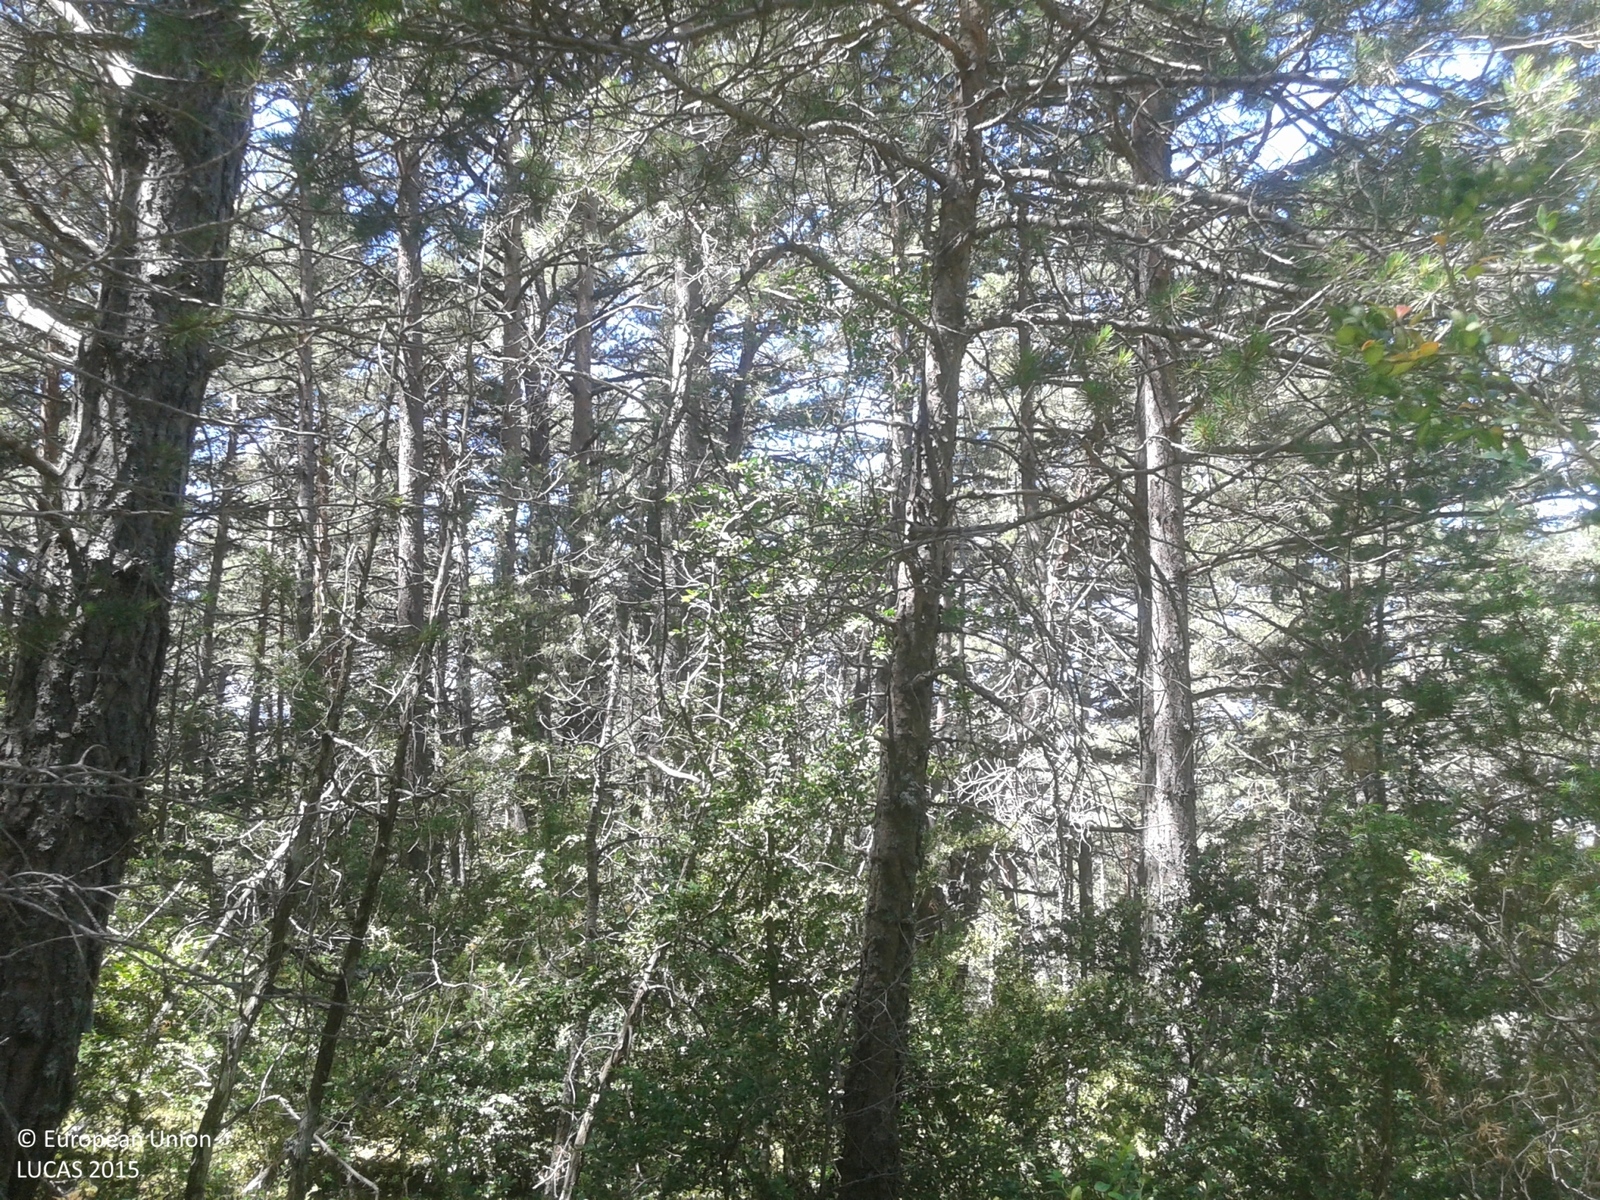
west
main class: Woodland
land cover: Pine dominated coniferous woodland
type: alpine coniferous forest
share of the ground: > 75 %
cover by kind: coniferous forest trees 80 %, shrubs 15 %, herbaceous plants 5 %
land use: Forestry
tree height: > 5 m
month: June
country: ES
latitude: 42.4224
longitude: 1.4901
